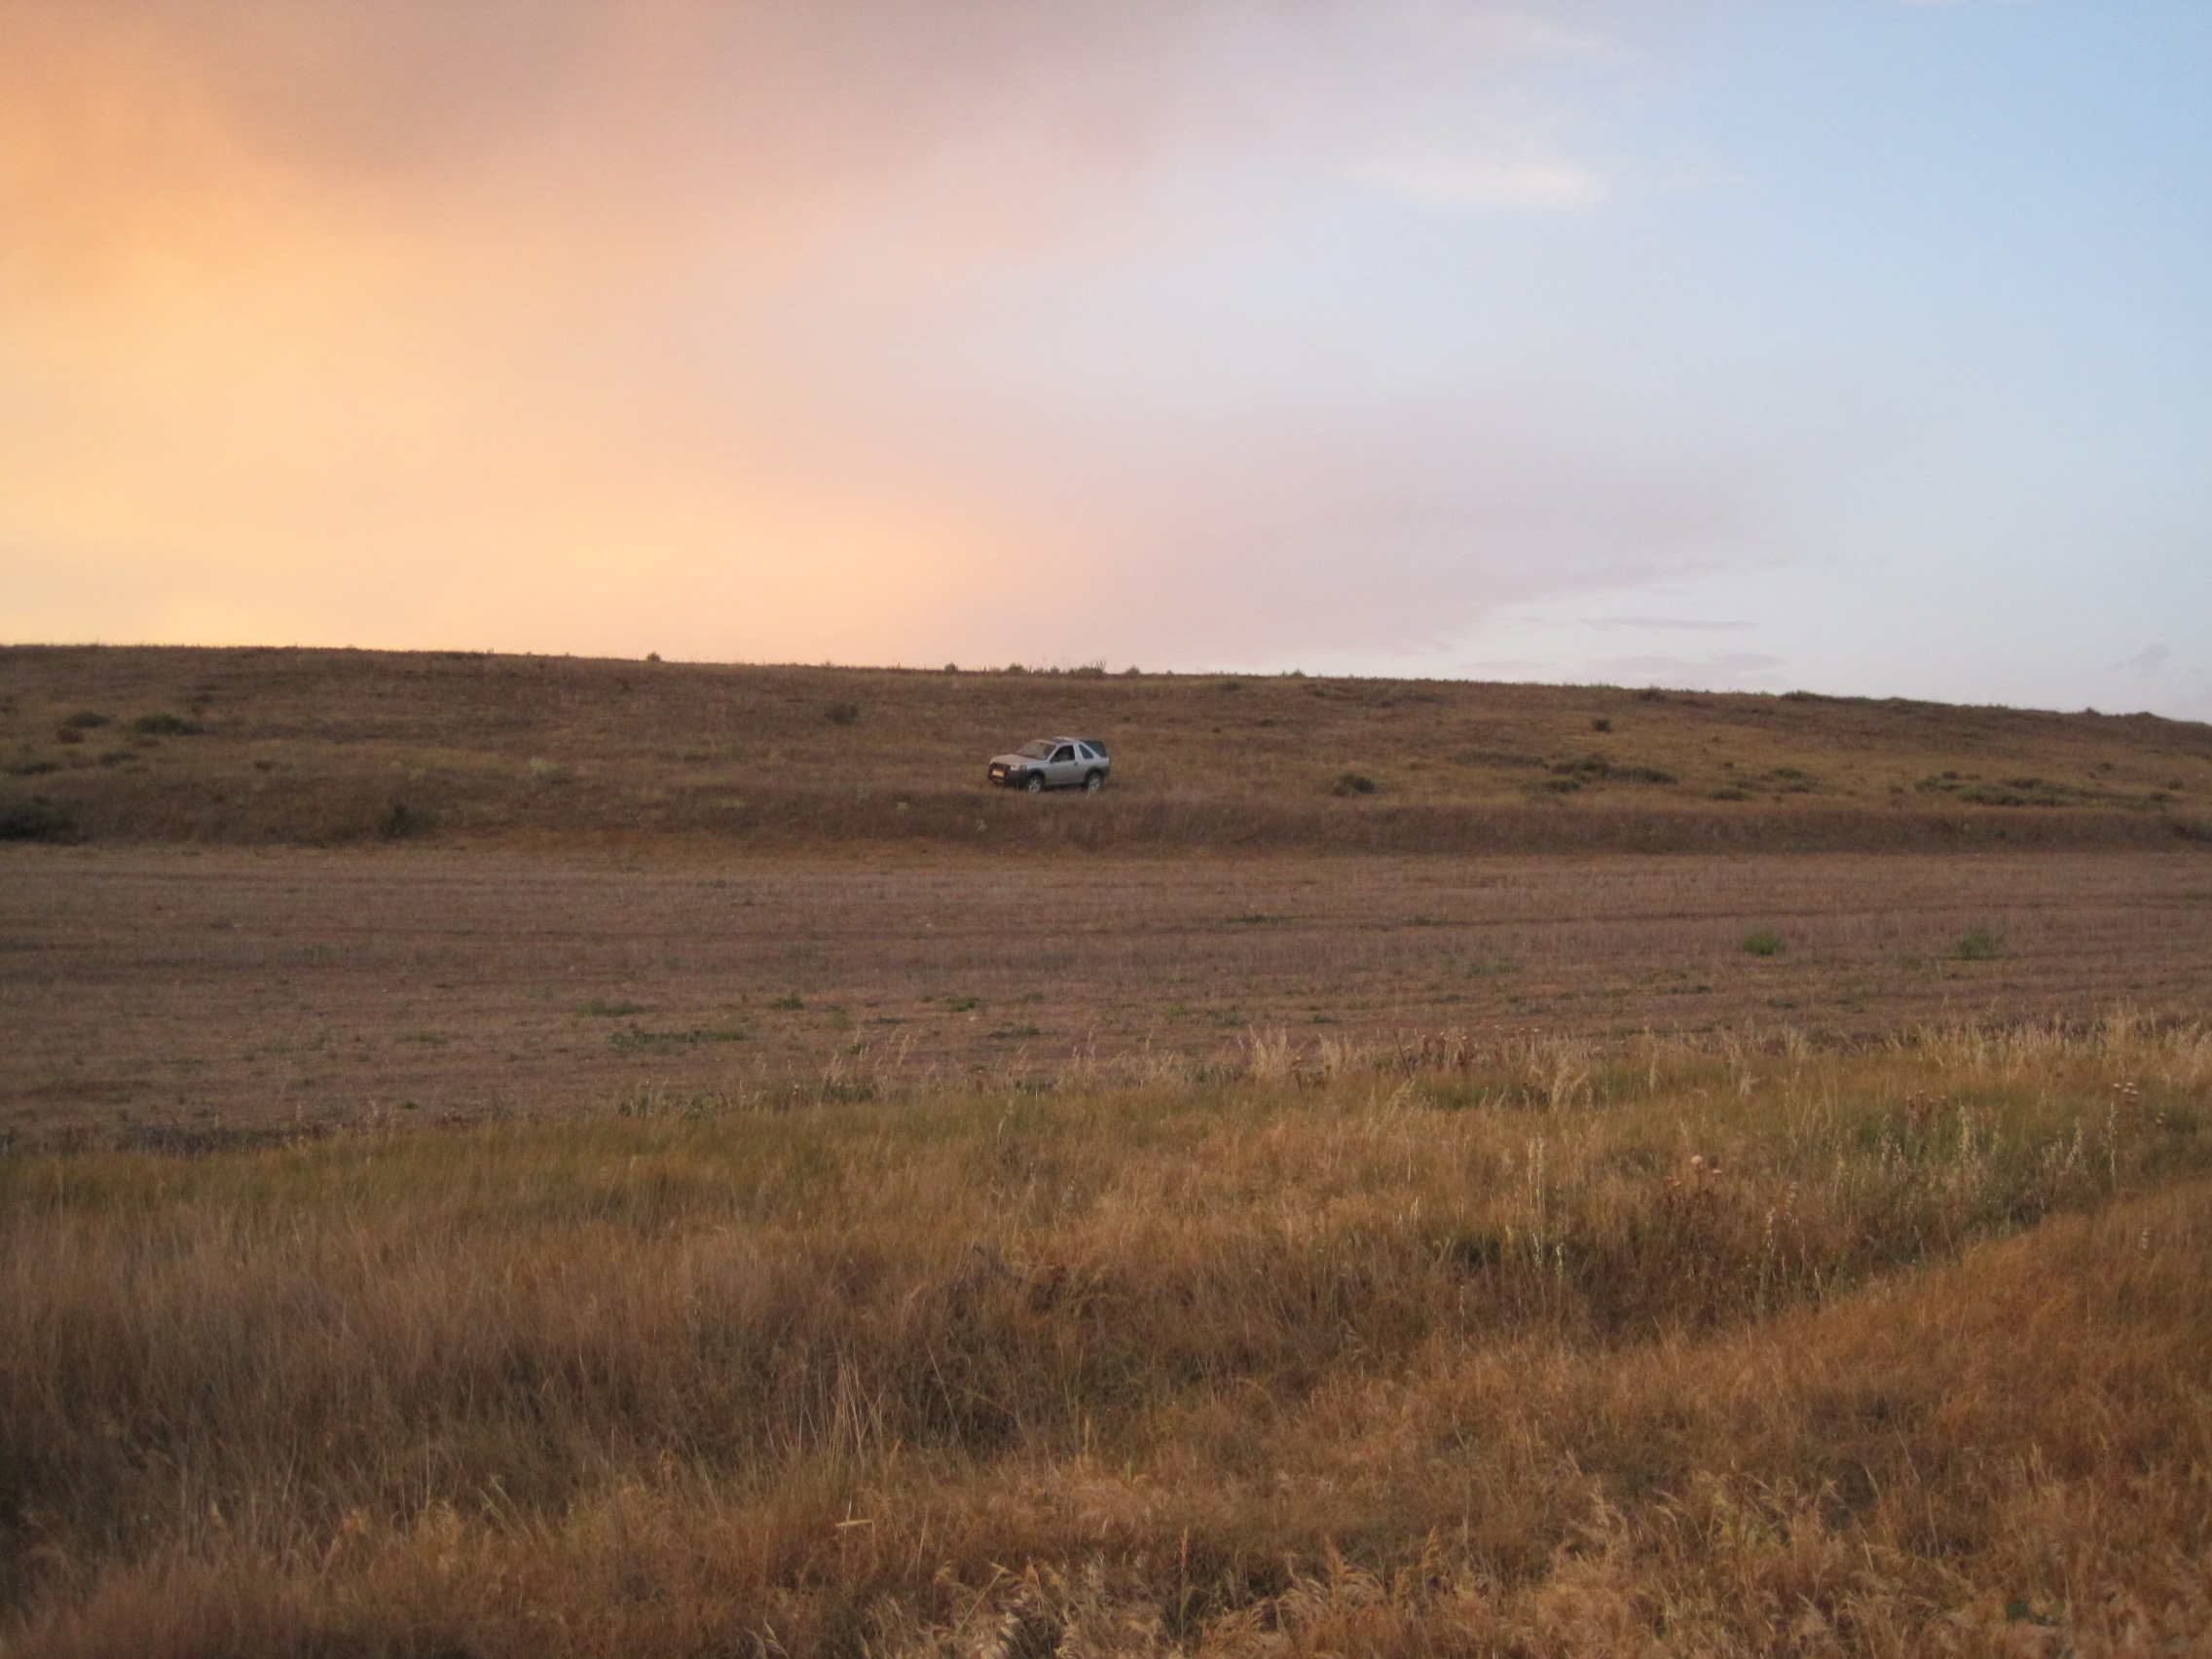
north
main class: Grassland
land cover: Grassland without tree/shrub cover
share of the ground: > 75 %
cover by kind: herbaceous plants 100 %
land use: Abandoned areas
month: July
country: ES
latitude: 41.7655
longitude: -5.4937
